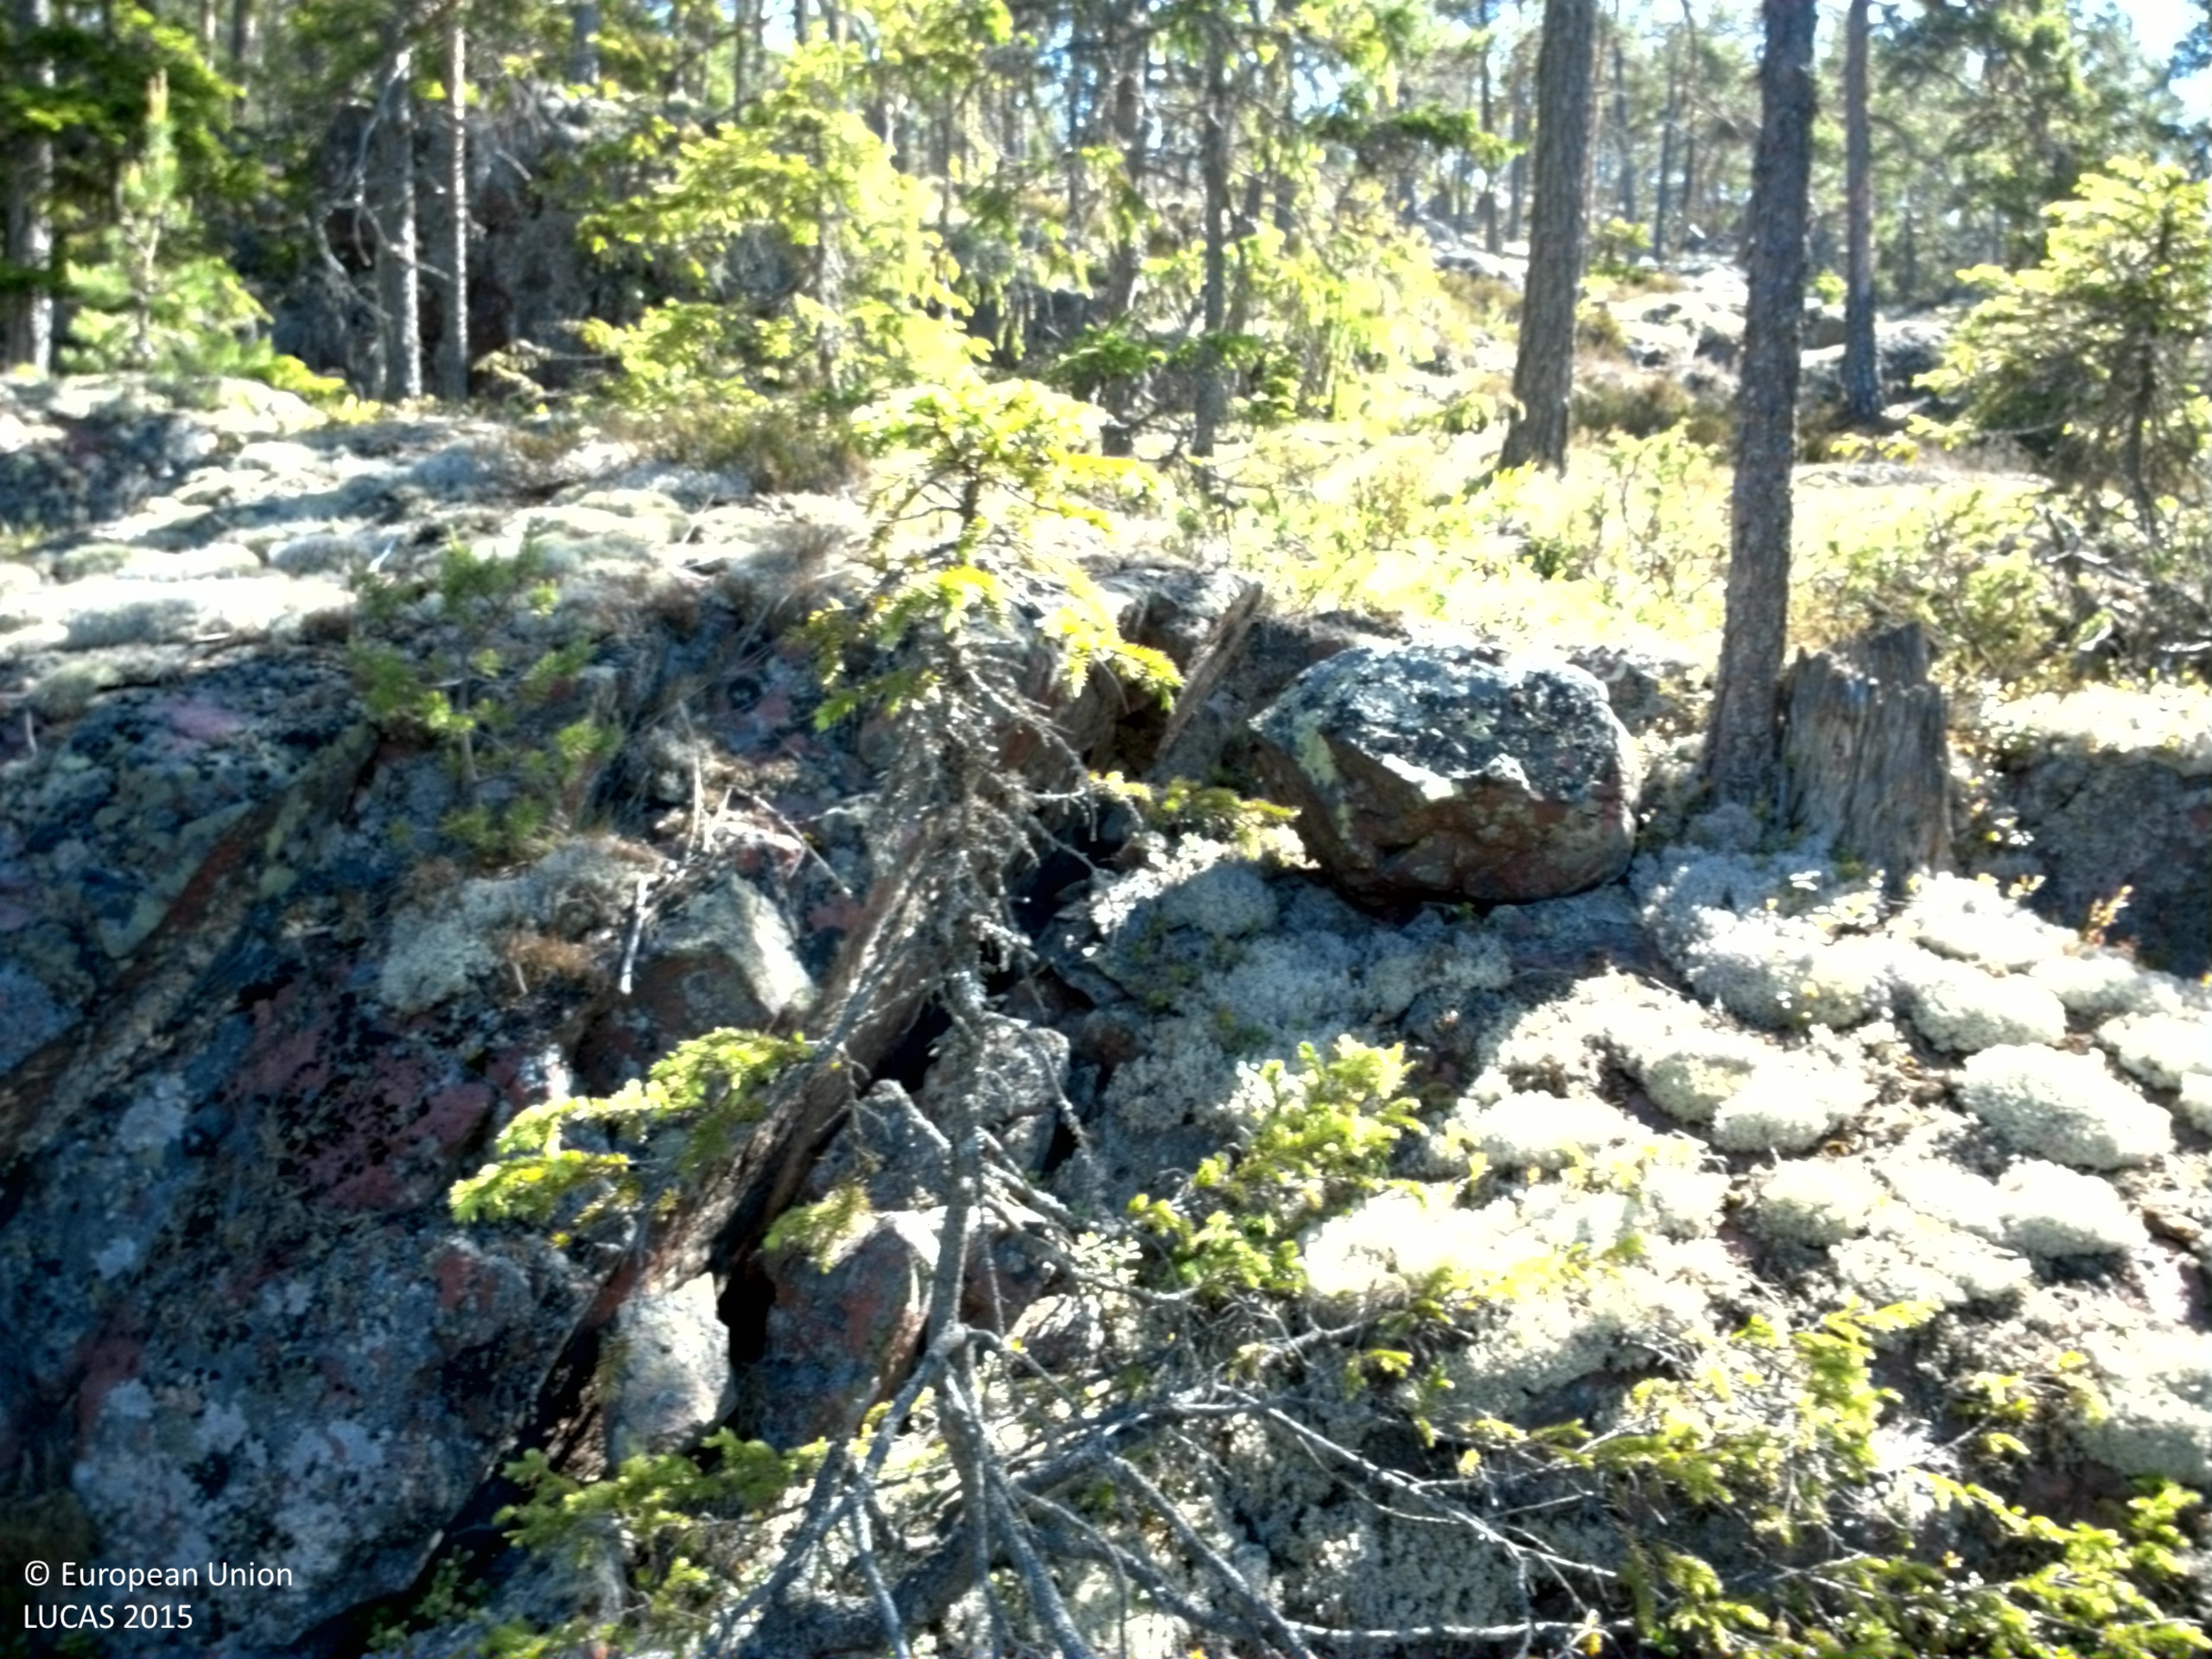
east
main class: Woodland
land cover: Pine dominated coniferous woodland
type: boreal forest
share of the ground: 50 - 75 %
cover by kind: coniferous forest trees 45 %, lichens and mosses 35 %, shrubs 10 %, consolidated bare surface 10 %
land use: Semi-natural and natural areas not in use
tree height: > 5 m
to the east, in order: Pine dominated coniferous woodland; Rocks and stones; Pine dominated coniferous woodland; Shrubland with sparse tree cover; Pine dominated coniferous woodland; Rocks and stones; Shrubland with sparse tree cover
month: June
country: SE
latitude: 63.0457
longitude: 18.4624
